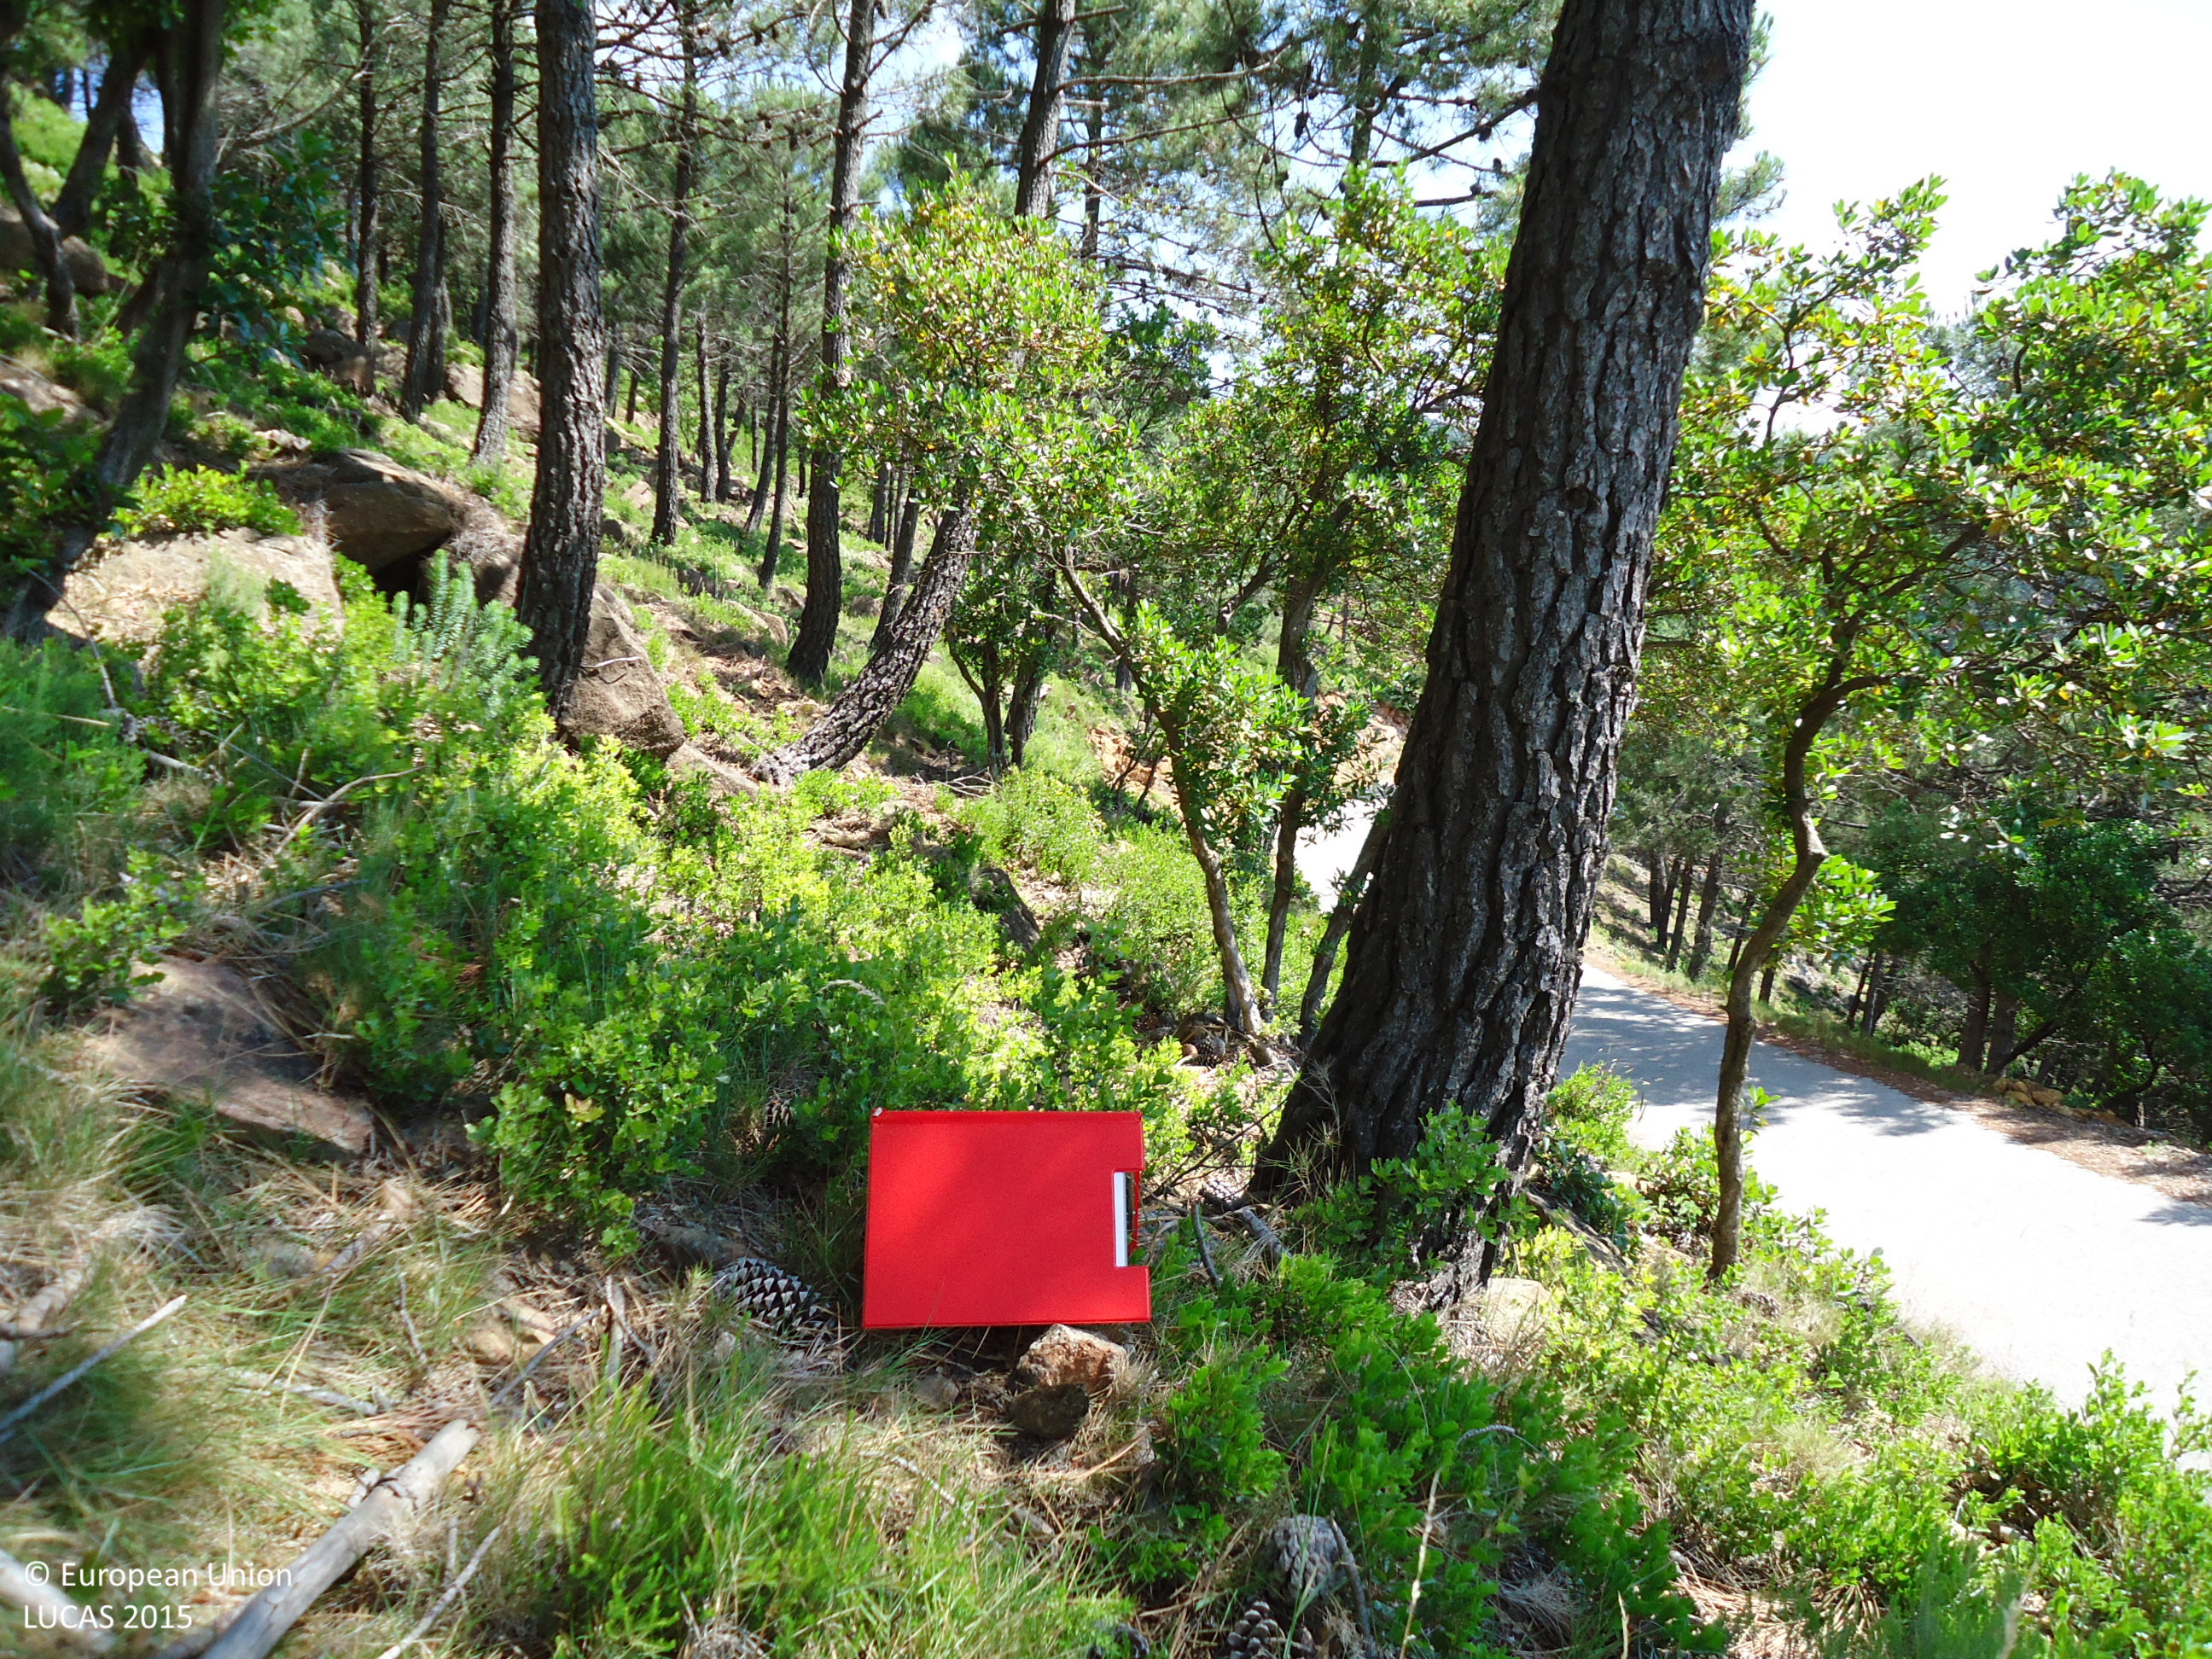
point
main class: Woodland
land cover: Pine dominated coniferous woodland
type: coniferous forest of the mediterranean region
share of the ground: > 75 %
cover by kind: coniferous forest trees 85 %, shrubs 5 %, herbaceous plants 5 %, consolidated bare surface 5 %
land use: Forestry
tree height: > 5 m
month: June
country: ES
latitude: 36.5012
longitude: -5.1899
